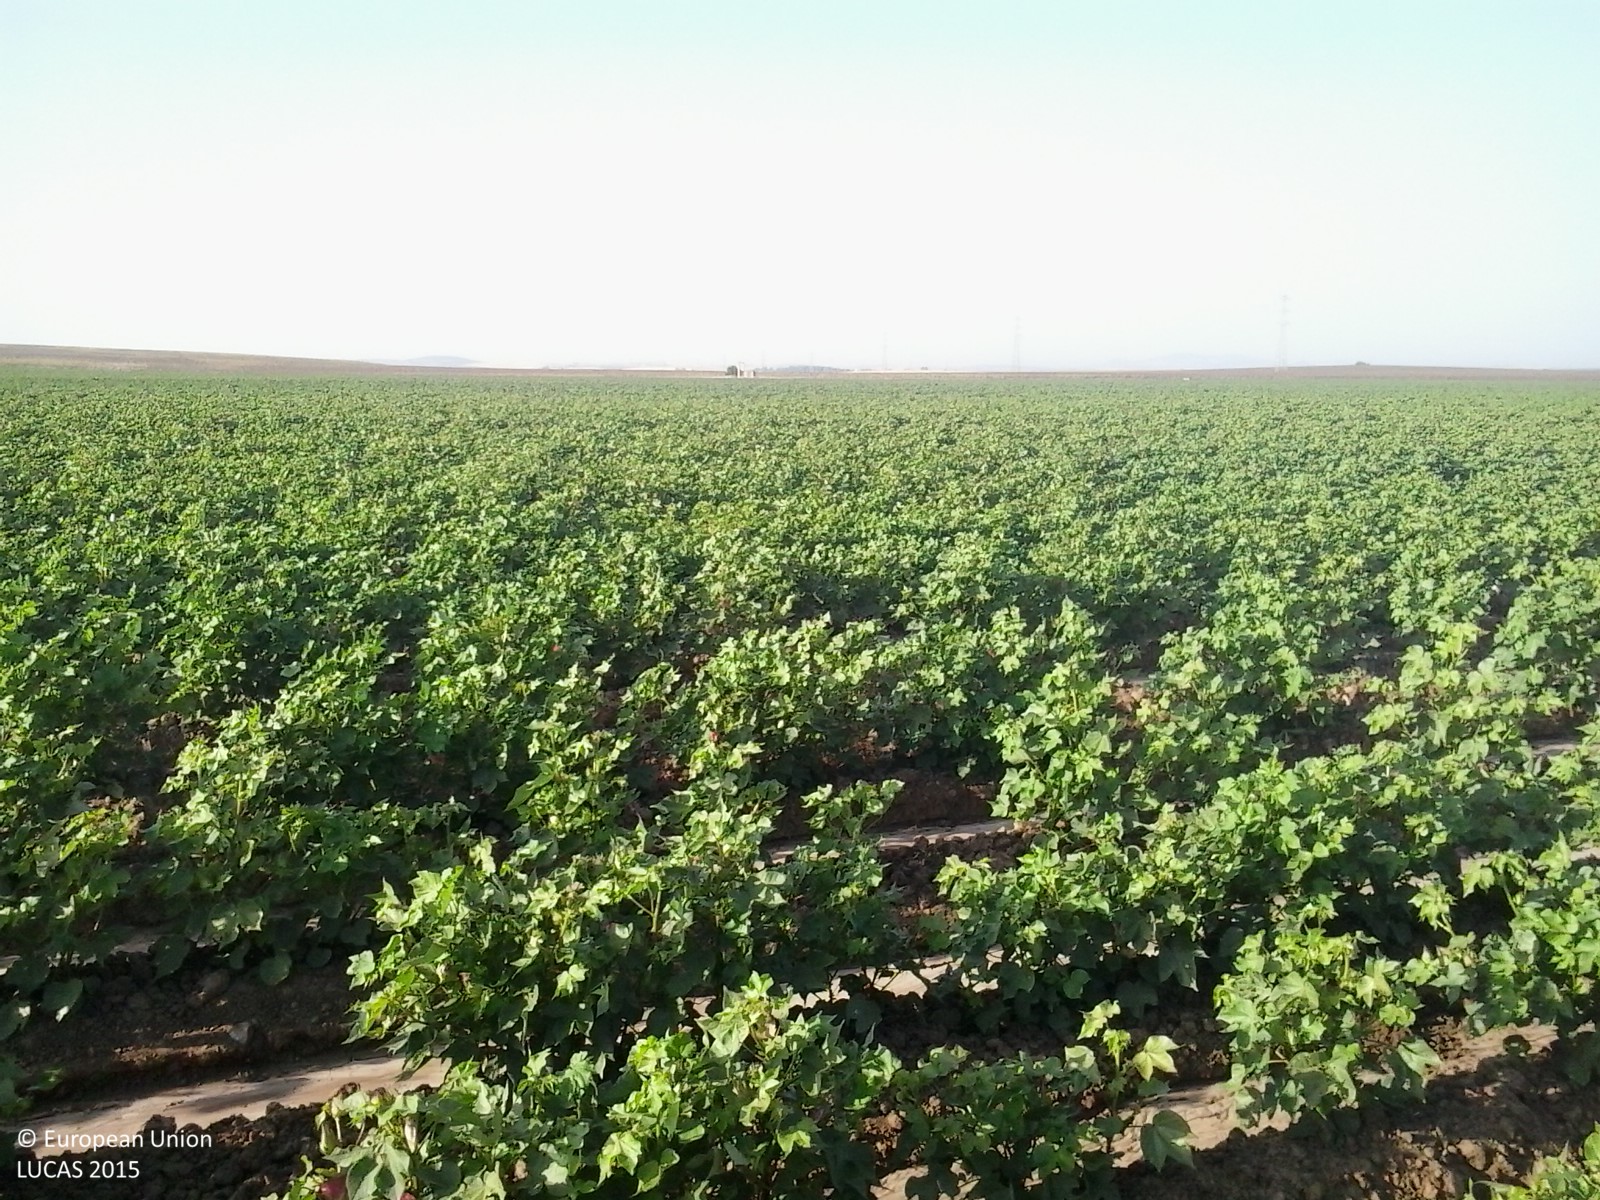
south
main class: Cropland
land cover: Cotton
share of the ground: 25 - 50 %
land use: Agriculture (excluding fallow land and kitchen gardens)
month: July
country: ES
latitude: 37.0958
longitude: -5.8232
